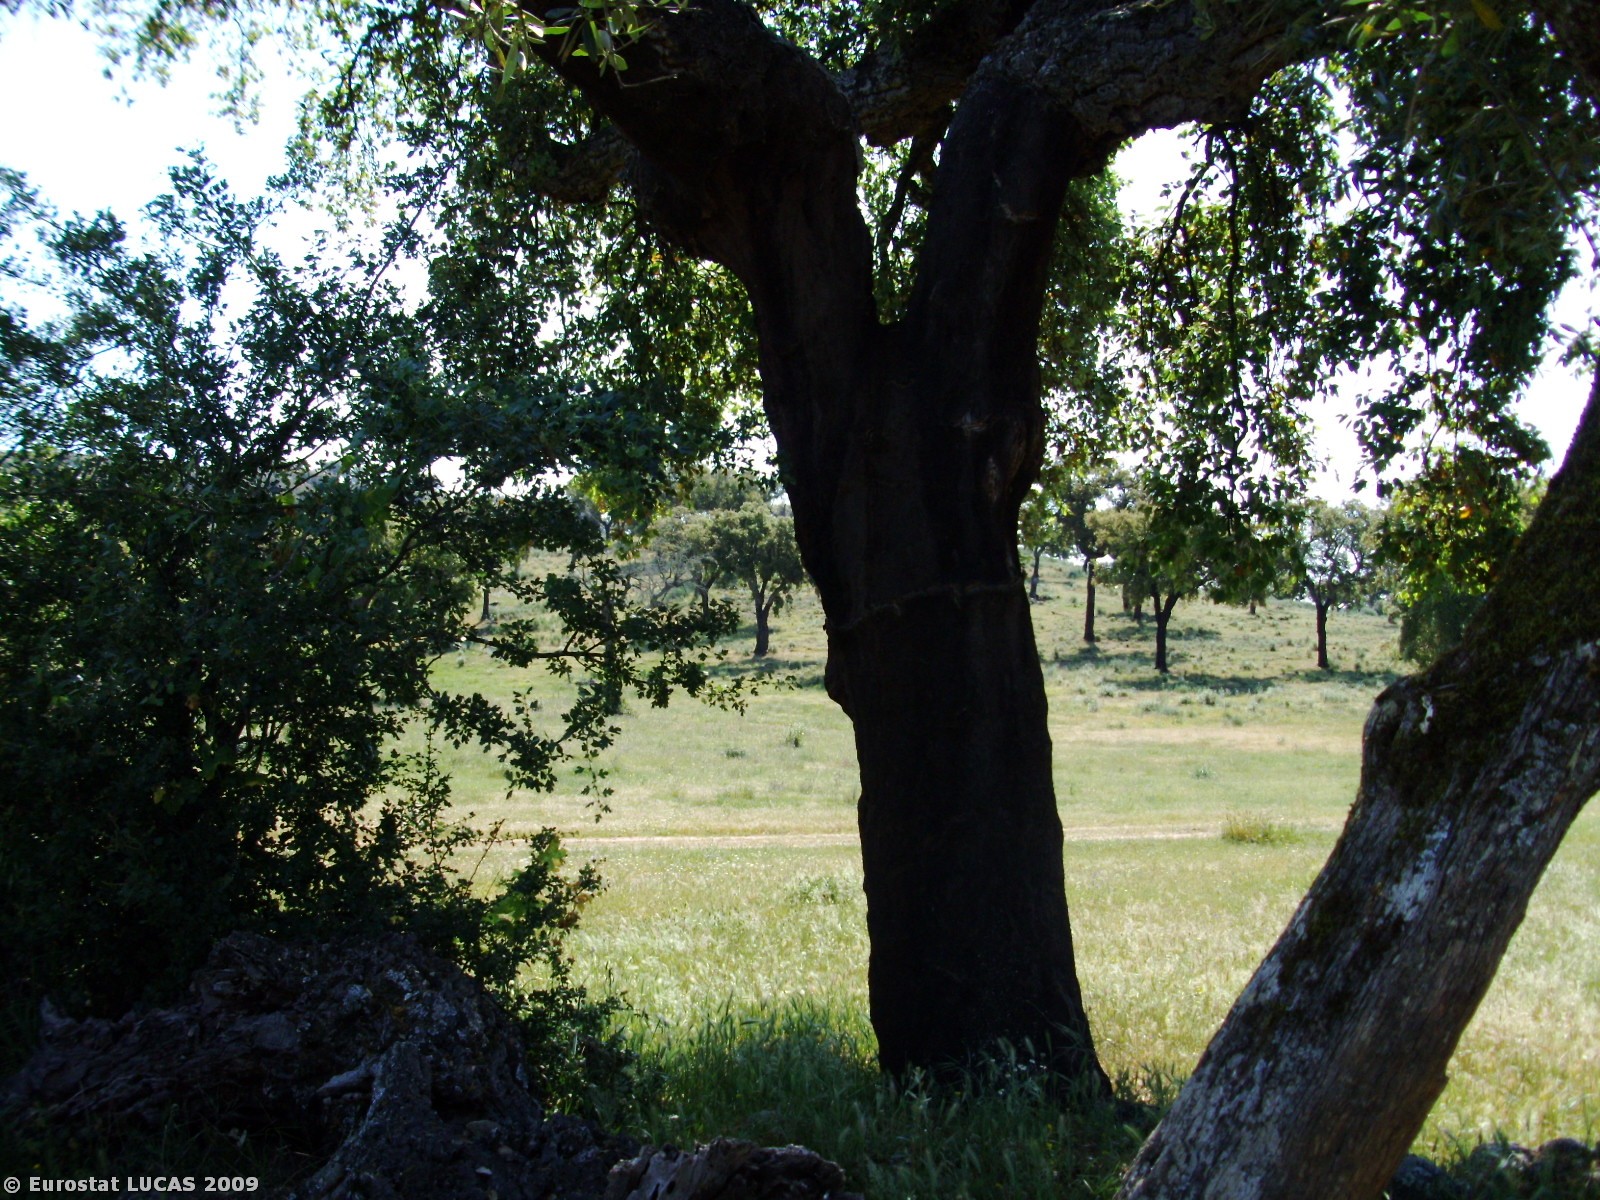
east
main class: Woodland
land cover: Broadleaved woodland
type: broadleaved evergreen forest
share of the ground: 25 - 50 %
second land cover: Grassland with sparse tree/shrub cover
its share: 50 - 75 %
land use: Forestry
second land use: Agriculture (excluding fallow land and kitchen gardens)
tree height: > 5 m
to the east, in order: Broadleaved woodland; Grassland with sparse tree/shrub cover; Tracks; Grassland without tree/shrub cover; Abandoned hedges; Ditches and canals; Broadleaved woodland
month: May
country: PT
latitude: 39.2685
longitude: -7.4150
